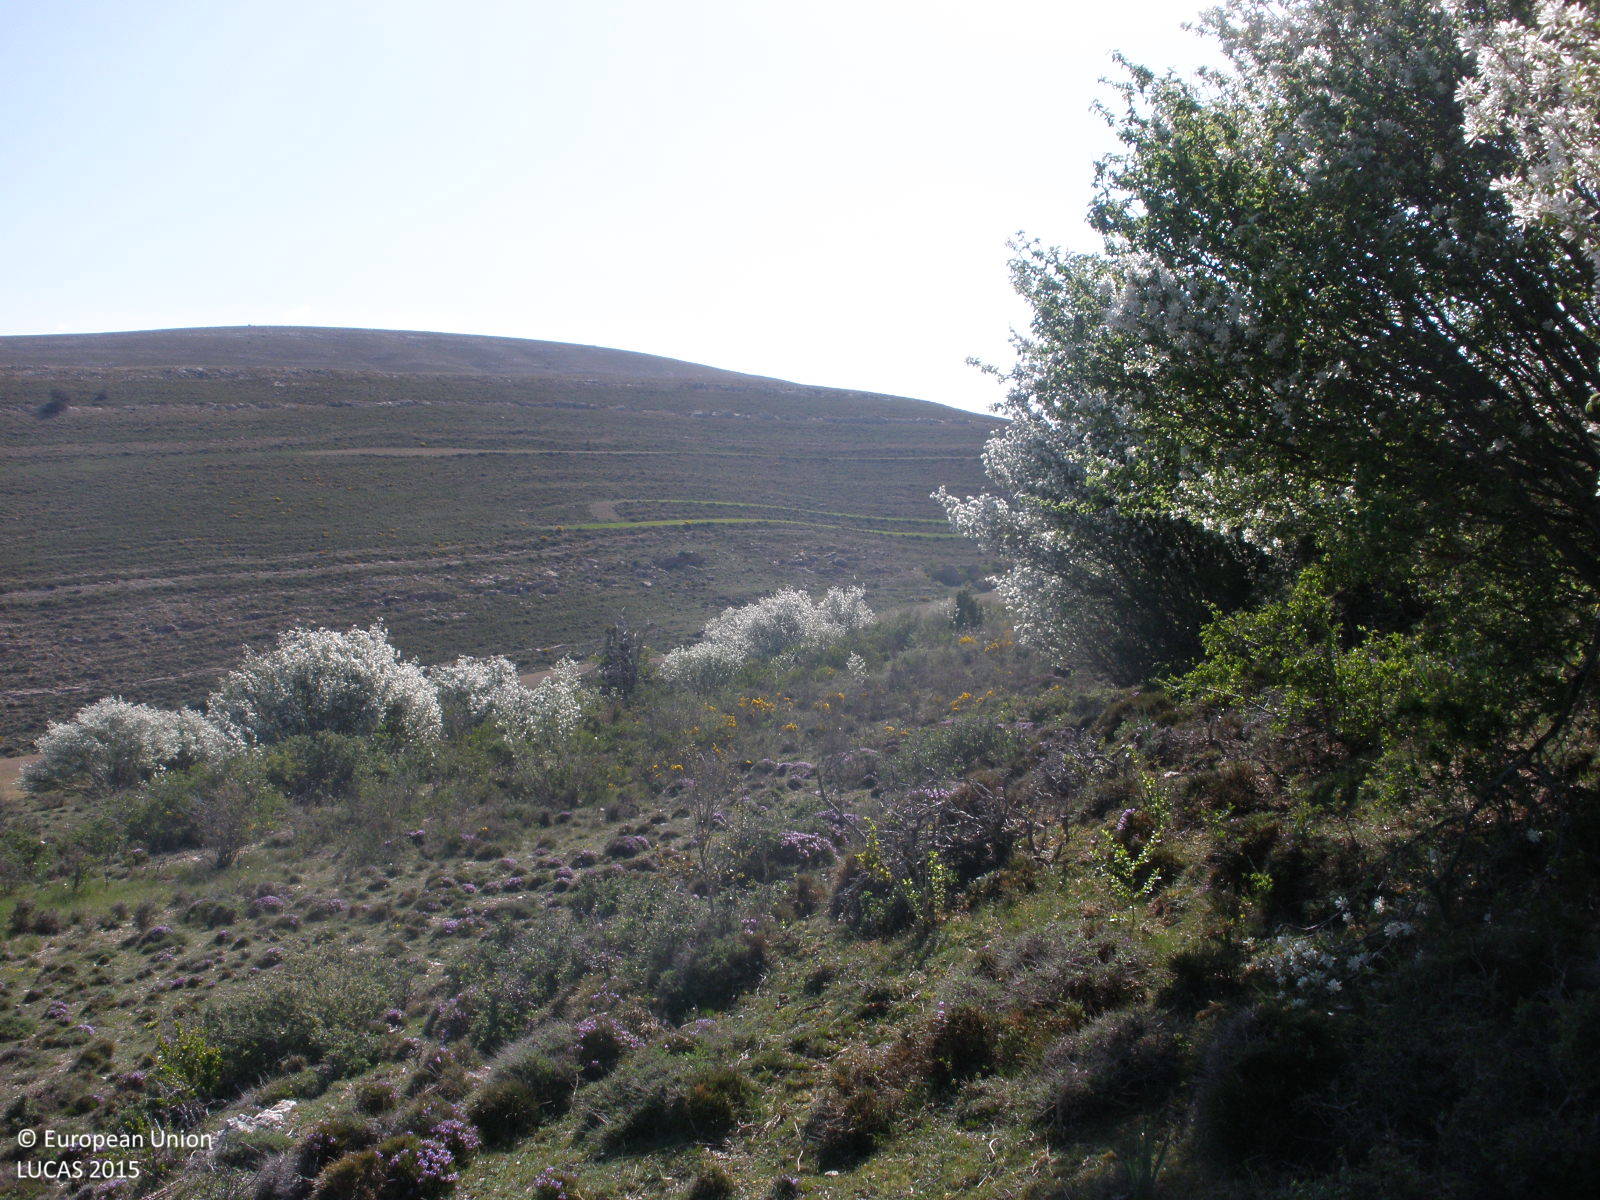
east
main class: Shrubland
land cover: Shrubland without tree cover
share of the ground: > 75 %
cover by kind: shrubs 70 %, herbaceous plants 30 %
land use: Agriculture (excluding fallow land and kitchen gardens)
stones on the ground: > 50 %
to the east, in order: Shrubland without tree cover; Spontaneously vegetated surfaces
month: May
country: ES
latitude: 40.6504
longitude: -0.8329
